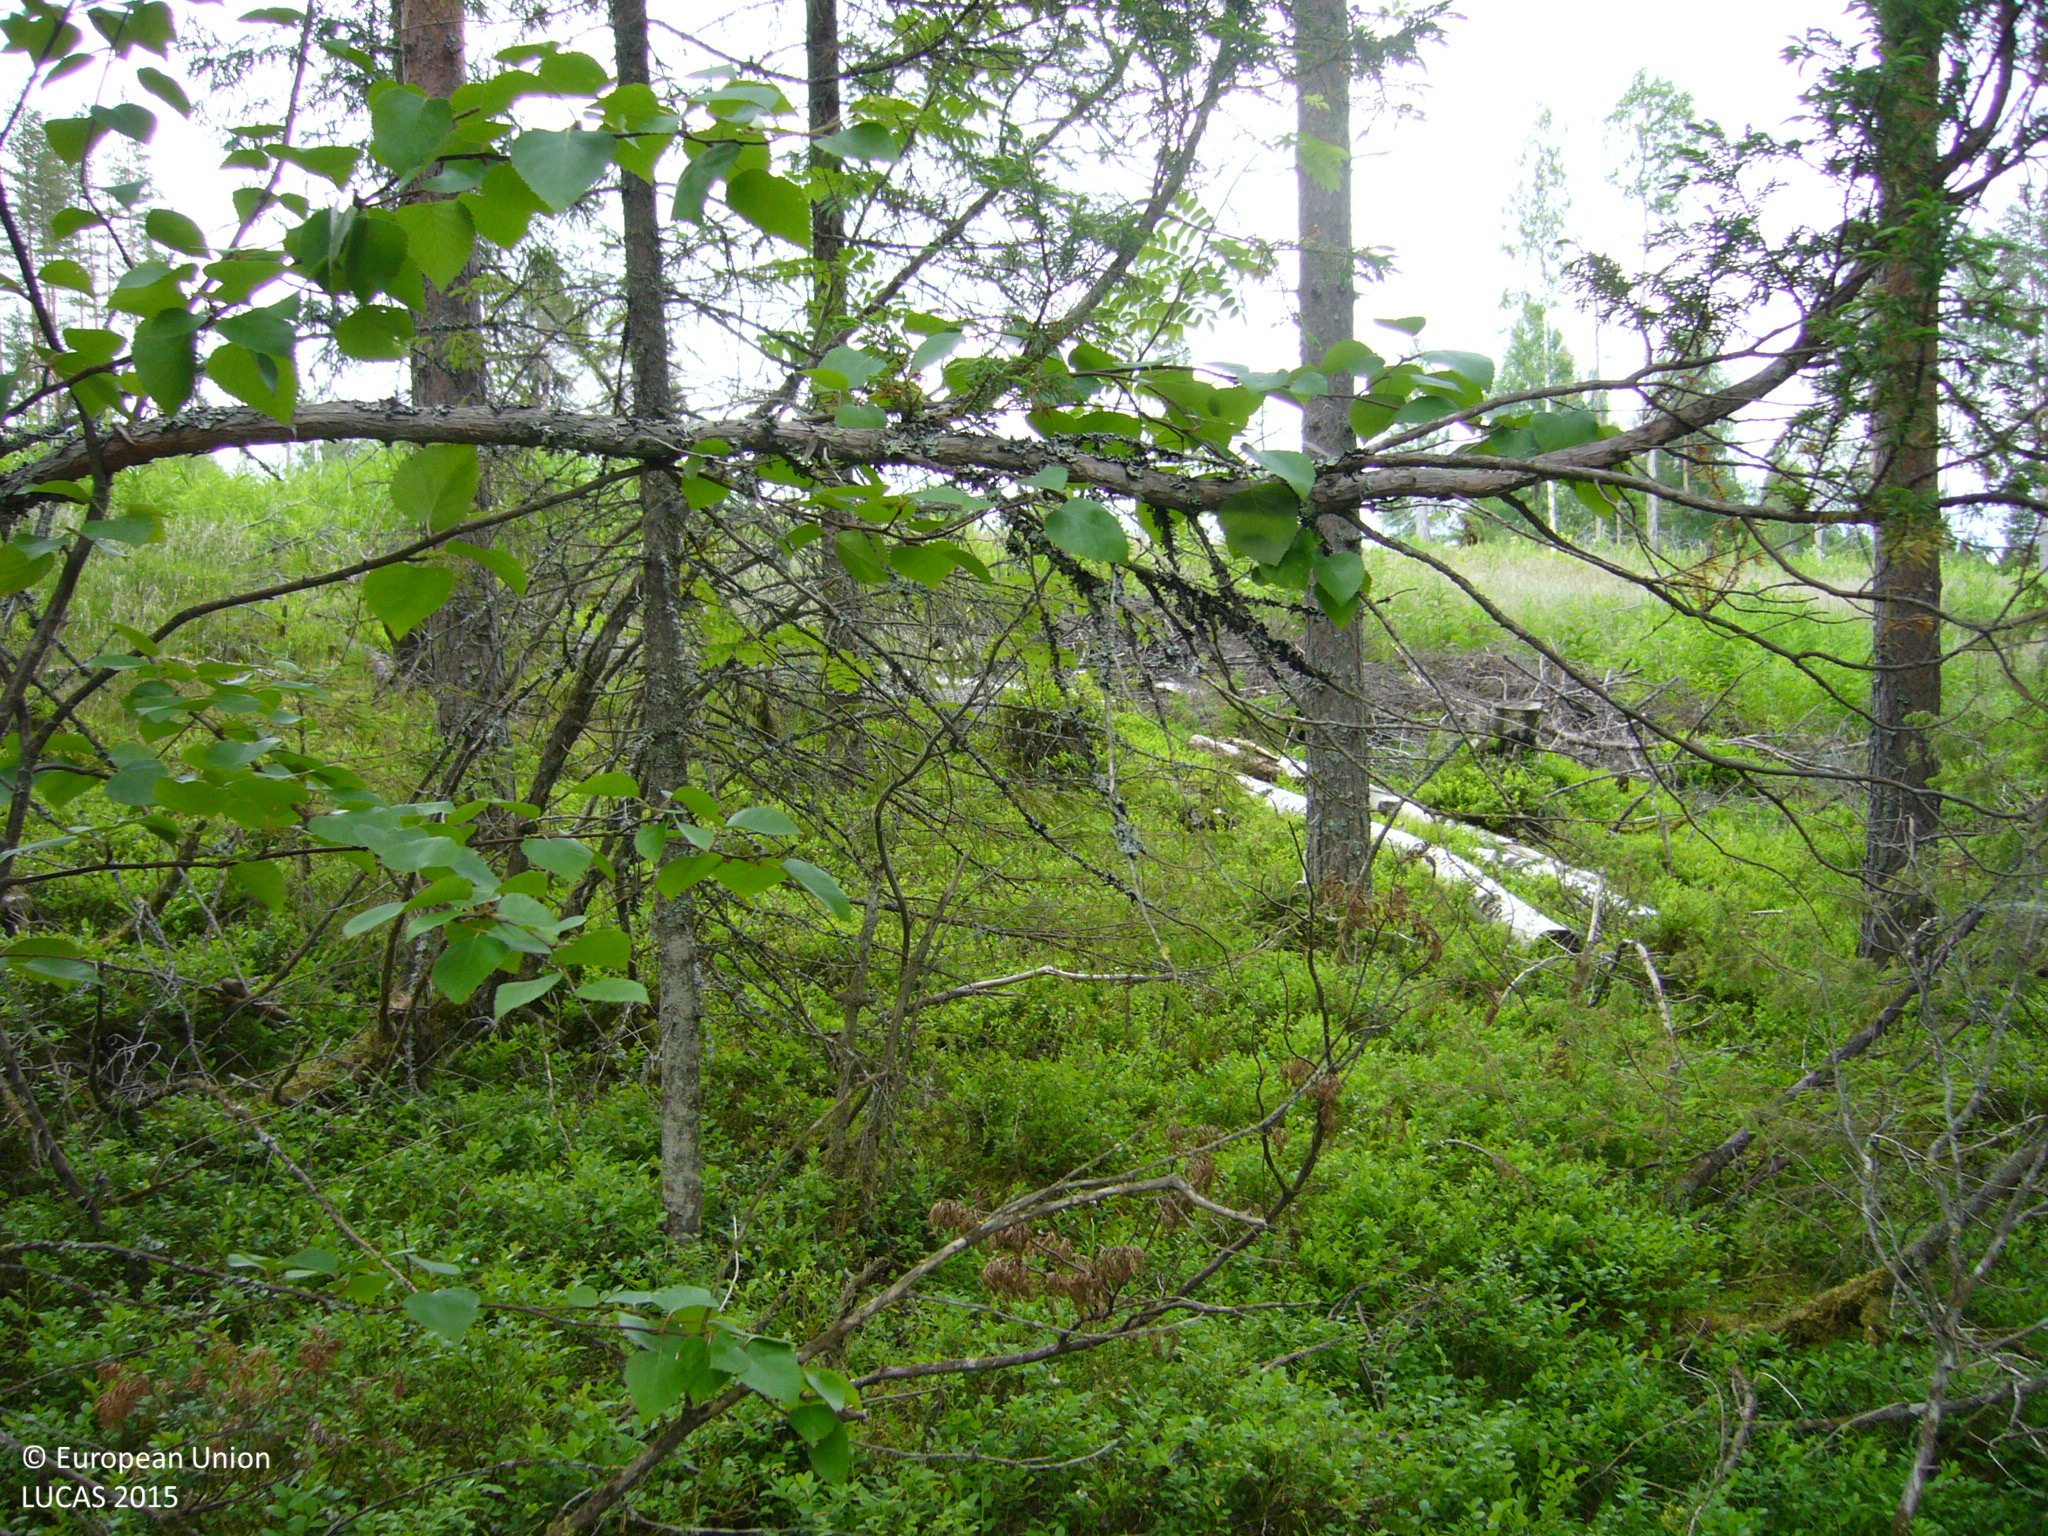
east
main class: Woodland
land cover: Pine dominated coniferous woodland
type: boreal forest
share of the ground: > 75 %
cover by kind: coniferous forest trees 70 %, shrubs 20 %, broadleaved forest trees 10 %
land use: Forestry
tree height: > 5 m
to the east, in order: Pine dominated coniferous woodland; Shrubland without tree cover; Spruce dominated mixed woodland; Dry stone walls; Shrubland without tree cover; Broadleaved woodland; Ditches and canals; Shrubland without tree cover; Dry stone walls; Spruce dominated mixed woodland
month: July
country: FI
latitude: 63.2910
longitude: 26.0920
